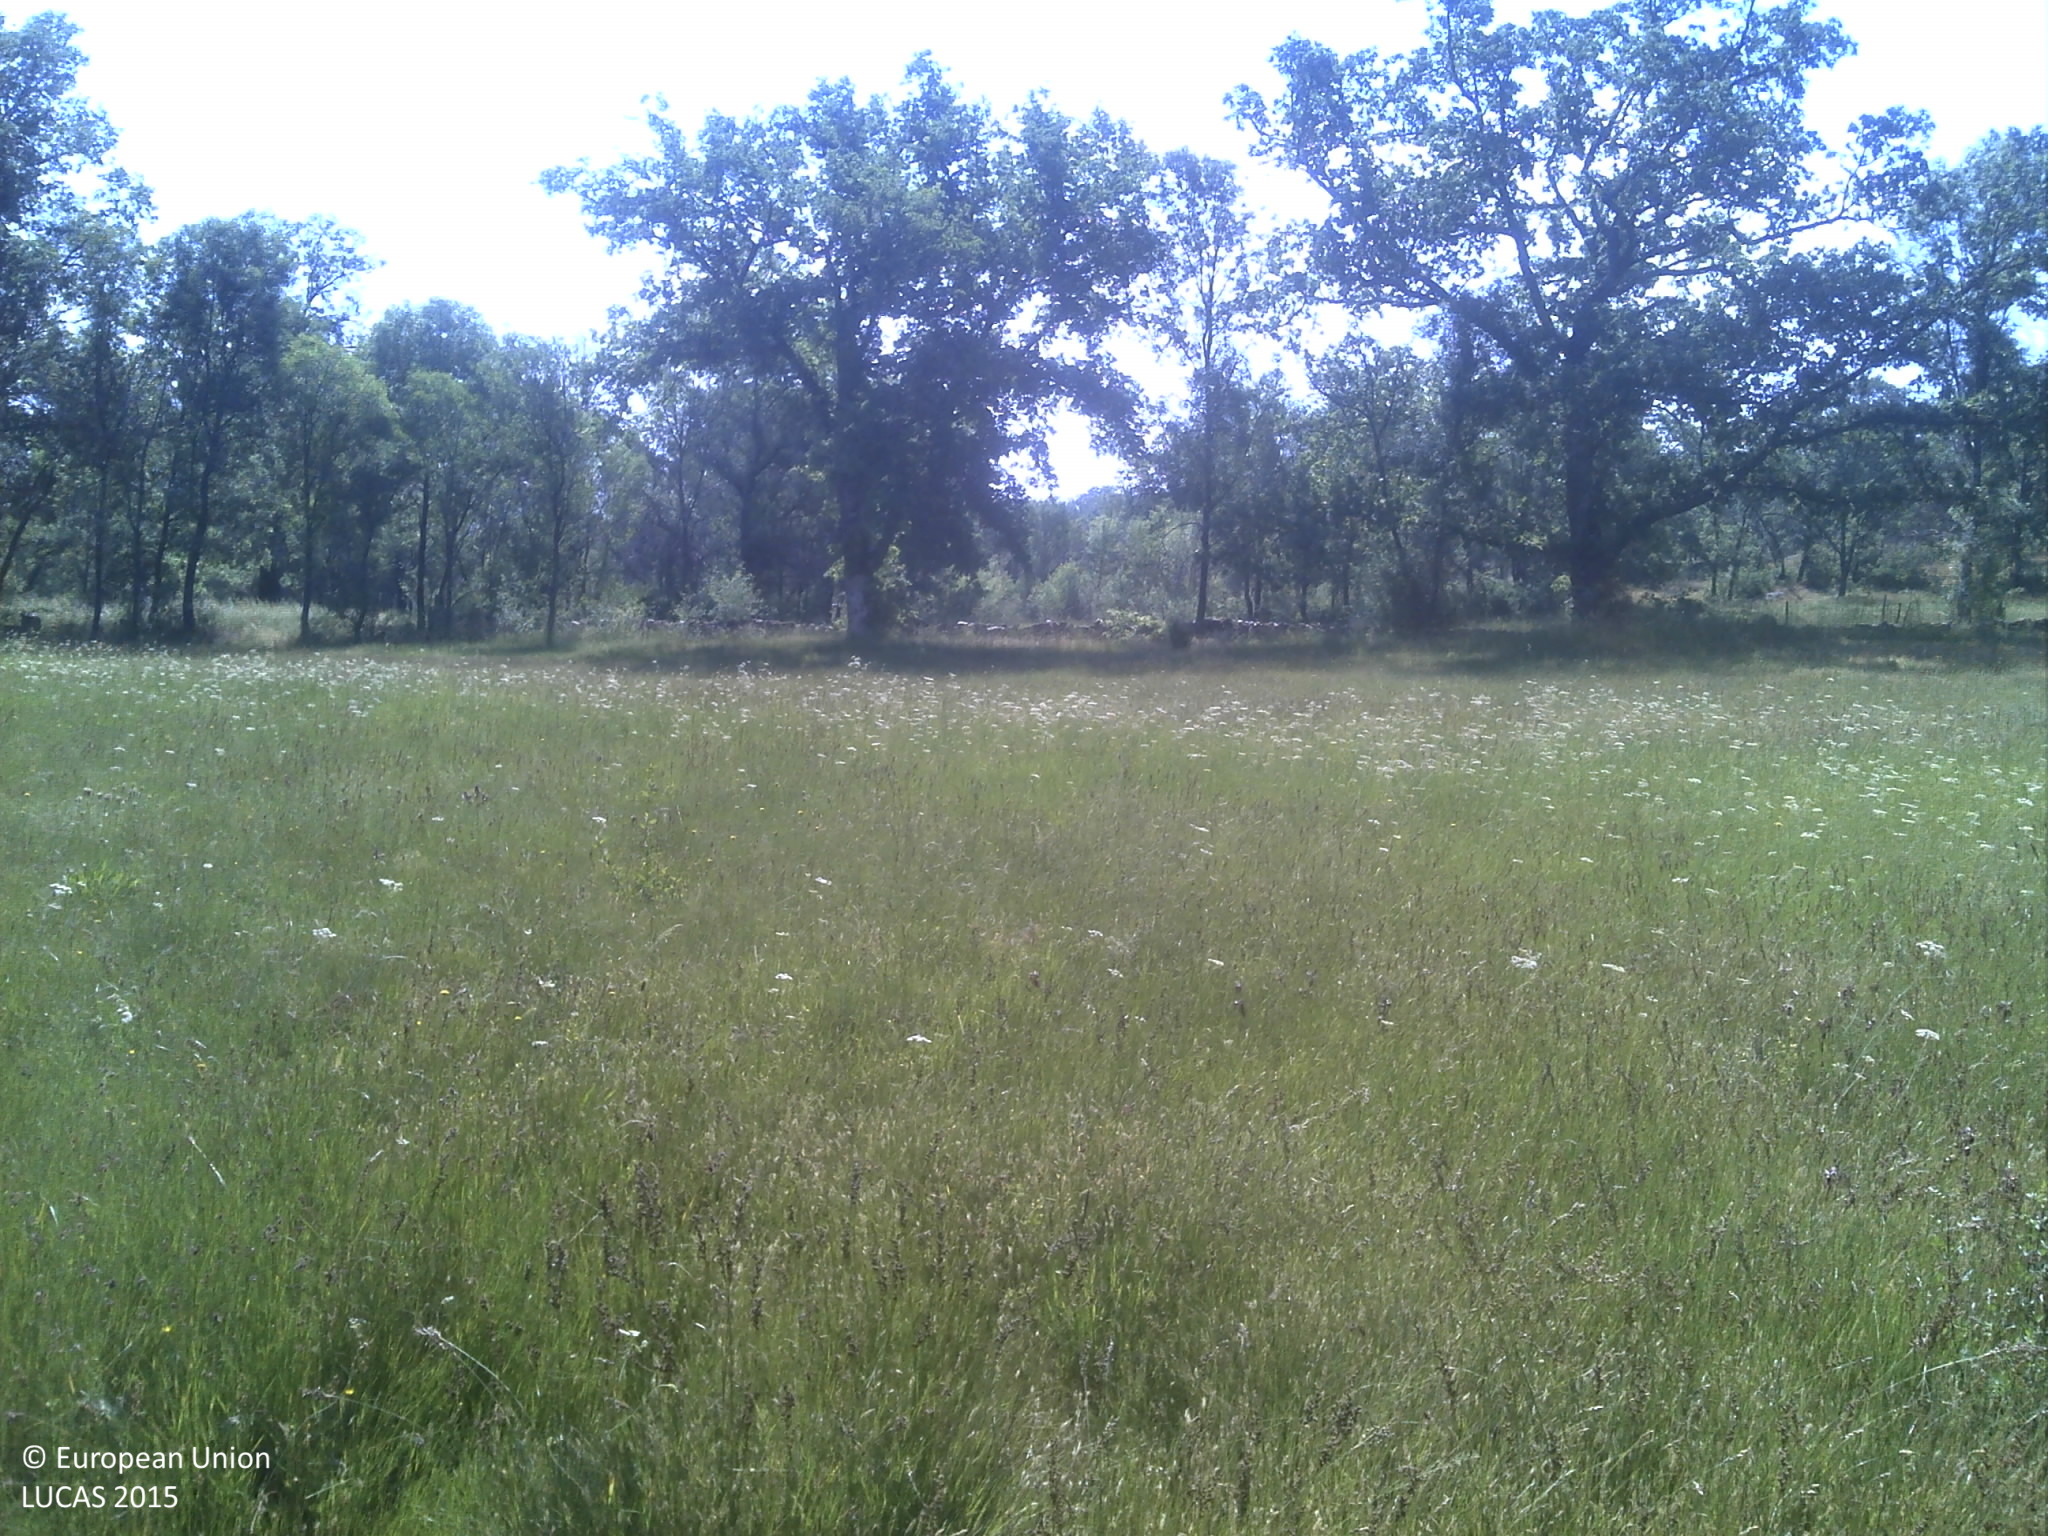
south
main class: Grassland
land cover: Grassland without tree/shrub cover
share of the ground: 50 - 75 %
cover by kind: herbaceous plants 75 %, unconsolidated bare surface 25 %
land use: Agriculture (excluding fallow land and kitchen gardens)
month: June
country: PT
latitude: 40.4136
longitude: -7.2017
